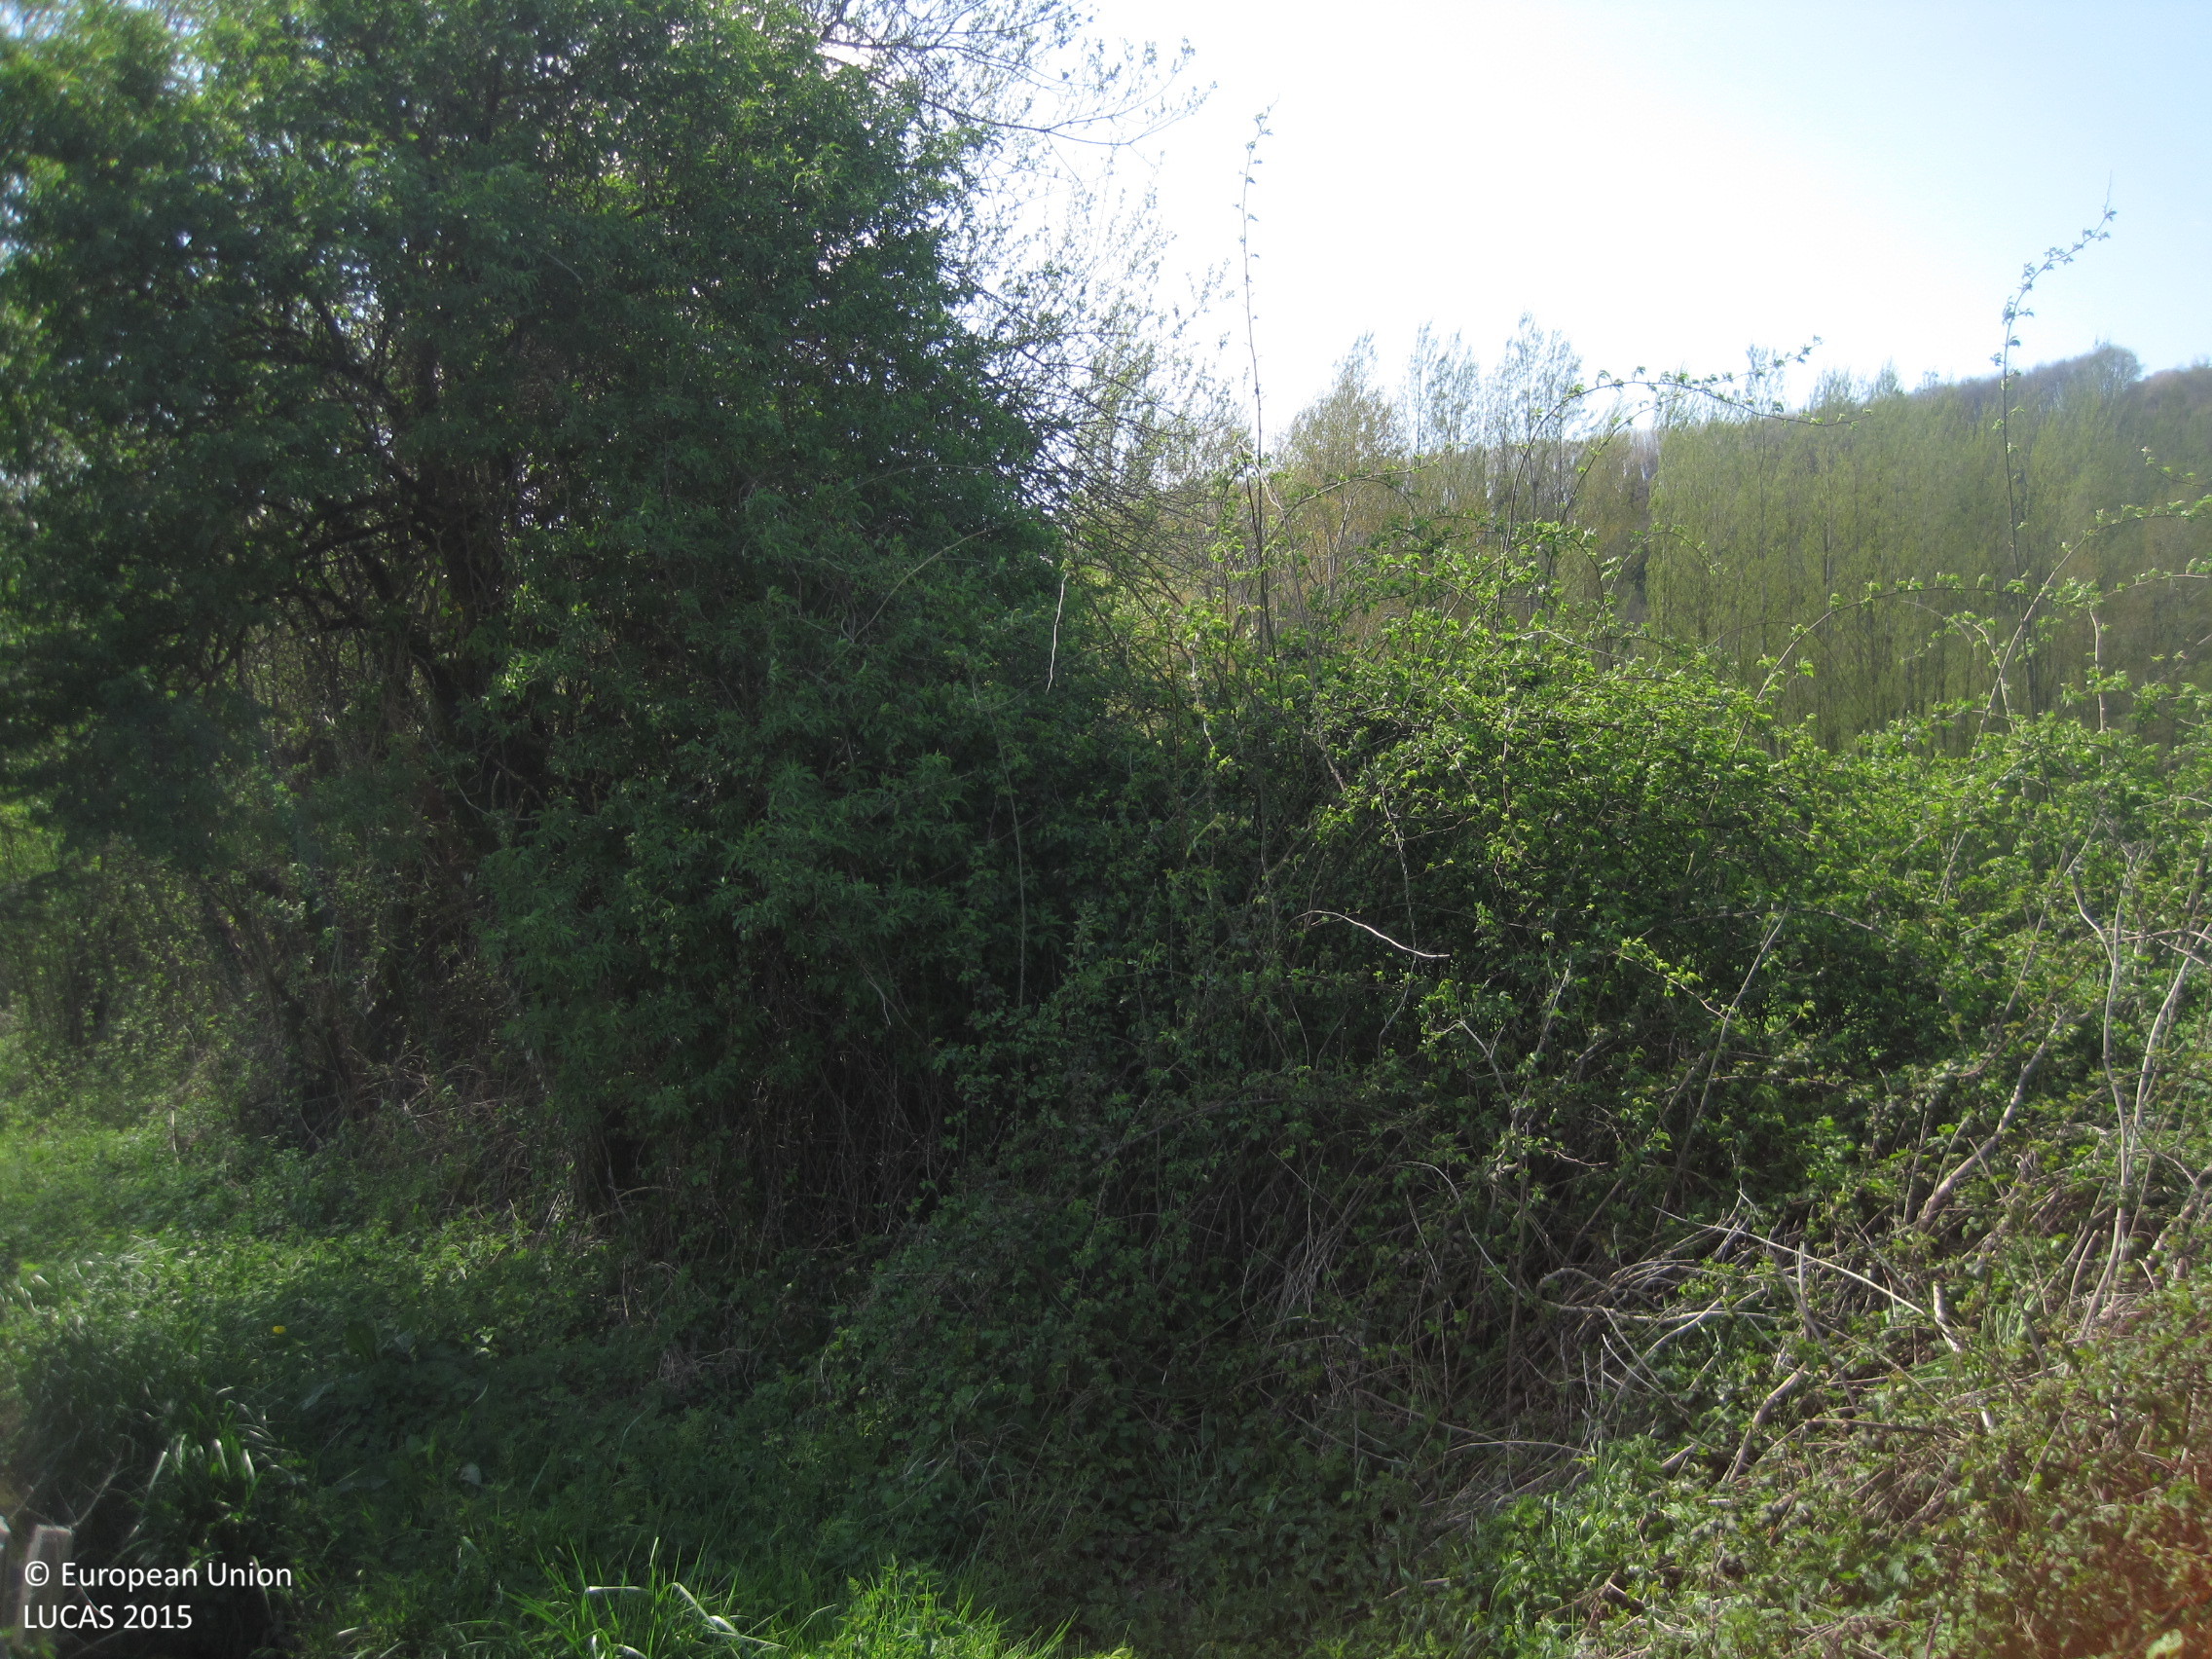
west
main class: Cropland
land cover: Other root crops
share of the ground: 10 - 25 %
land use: Kitchen garden
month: April
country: ES
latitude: 42.8799
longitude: -2.2031
